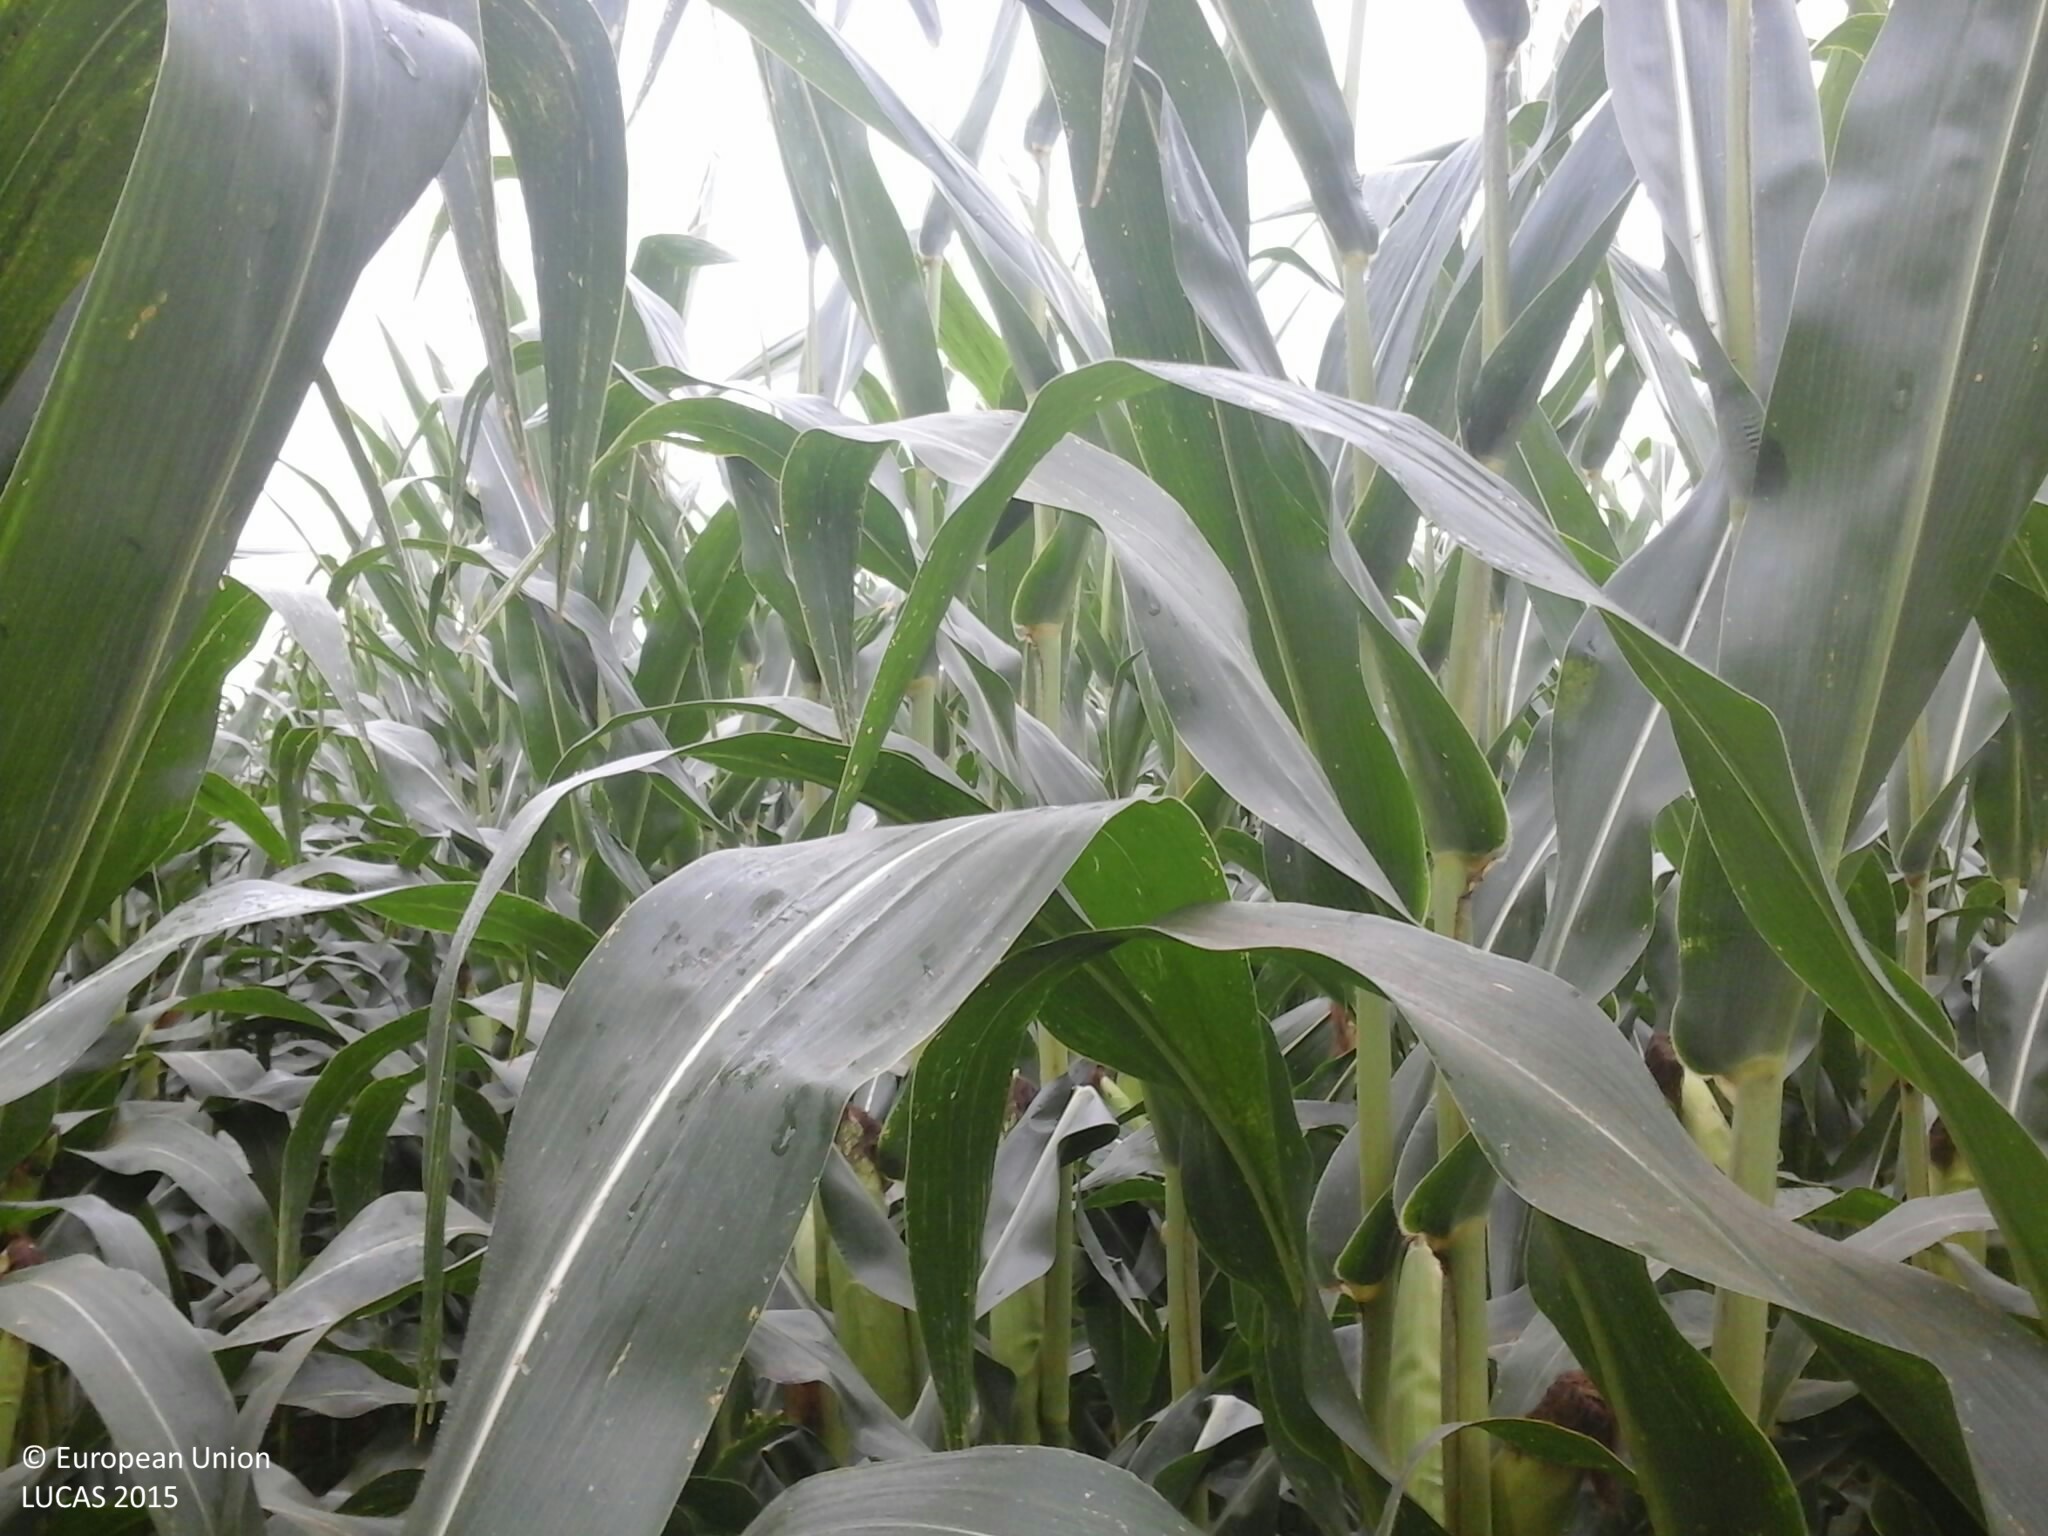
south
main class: Cropland
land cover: Maize
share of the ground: > 75 %
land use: Agriculture (excluding fallow land and kitchen gardens)
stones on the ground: < 10 %
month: July
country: HU
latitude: 46.7471
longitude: 17.6376
